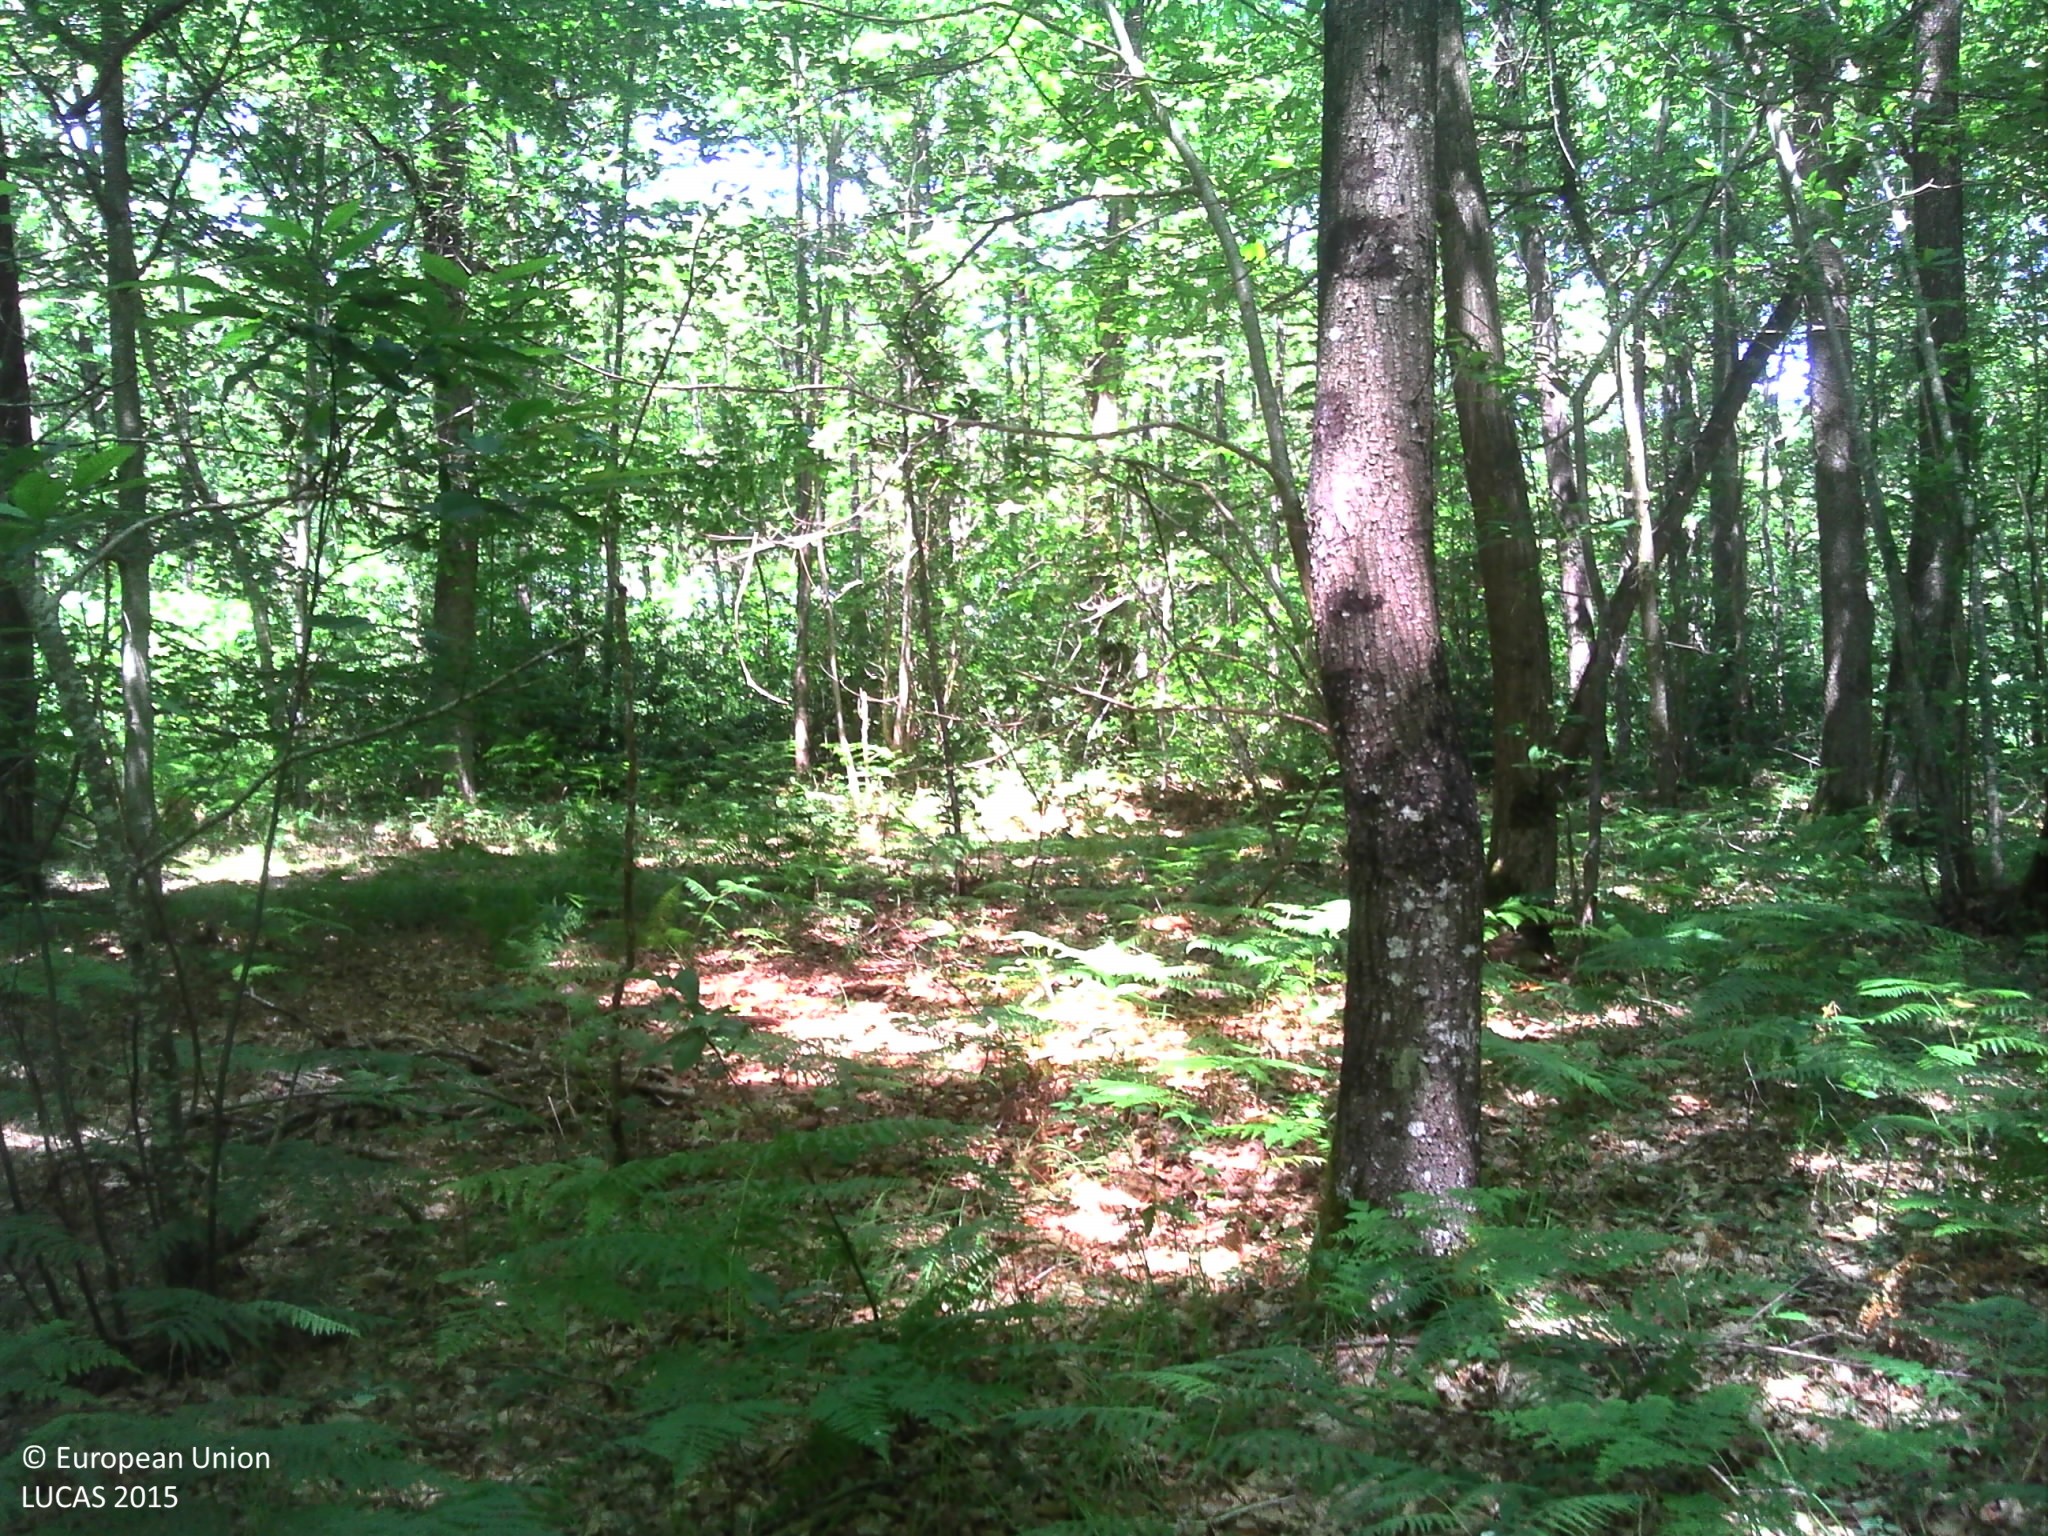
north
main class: Woodland
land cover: Broadleaved woodland
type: mesophytic deciduous forest
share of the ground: > 75 %
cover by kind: broadleaved forest trees 80 %, herbaceous plants 10 %, coniferous forest trees 5 %, lichens and mosses 5 %
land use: Forestry
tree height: > 5 m
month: June
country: FR
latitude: 47.5474
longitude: 0.3706
